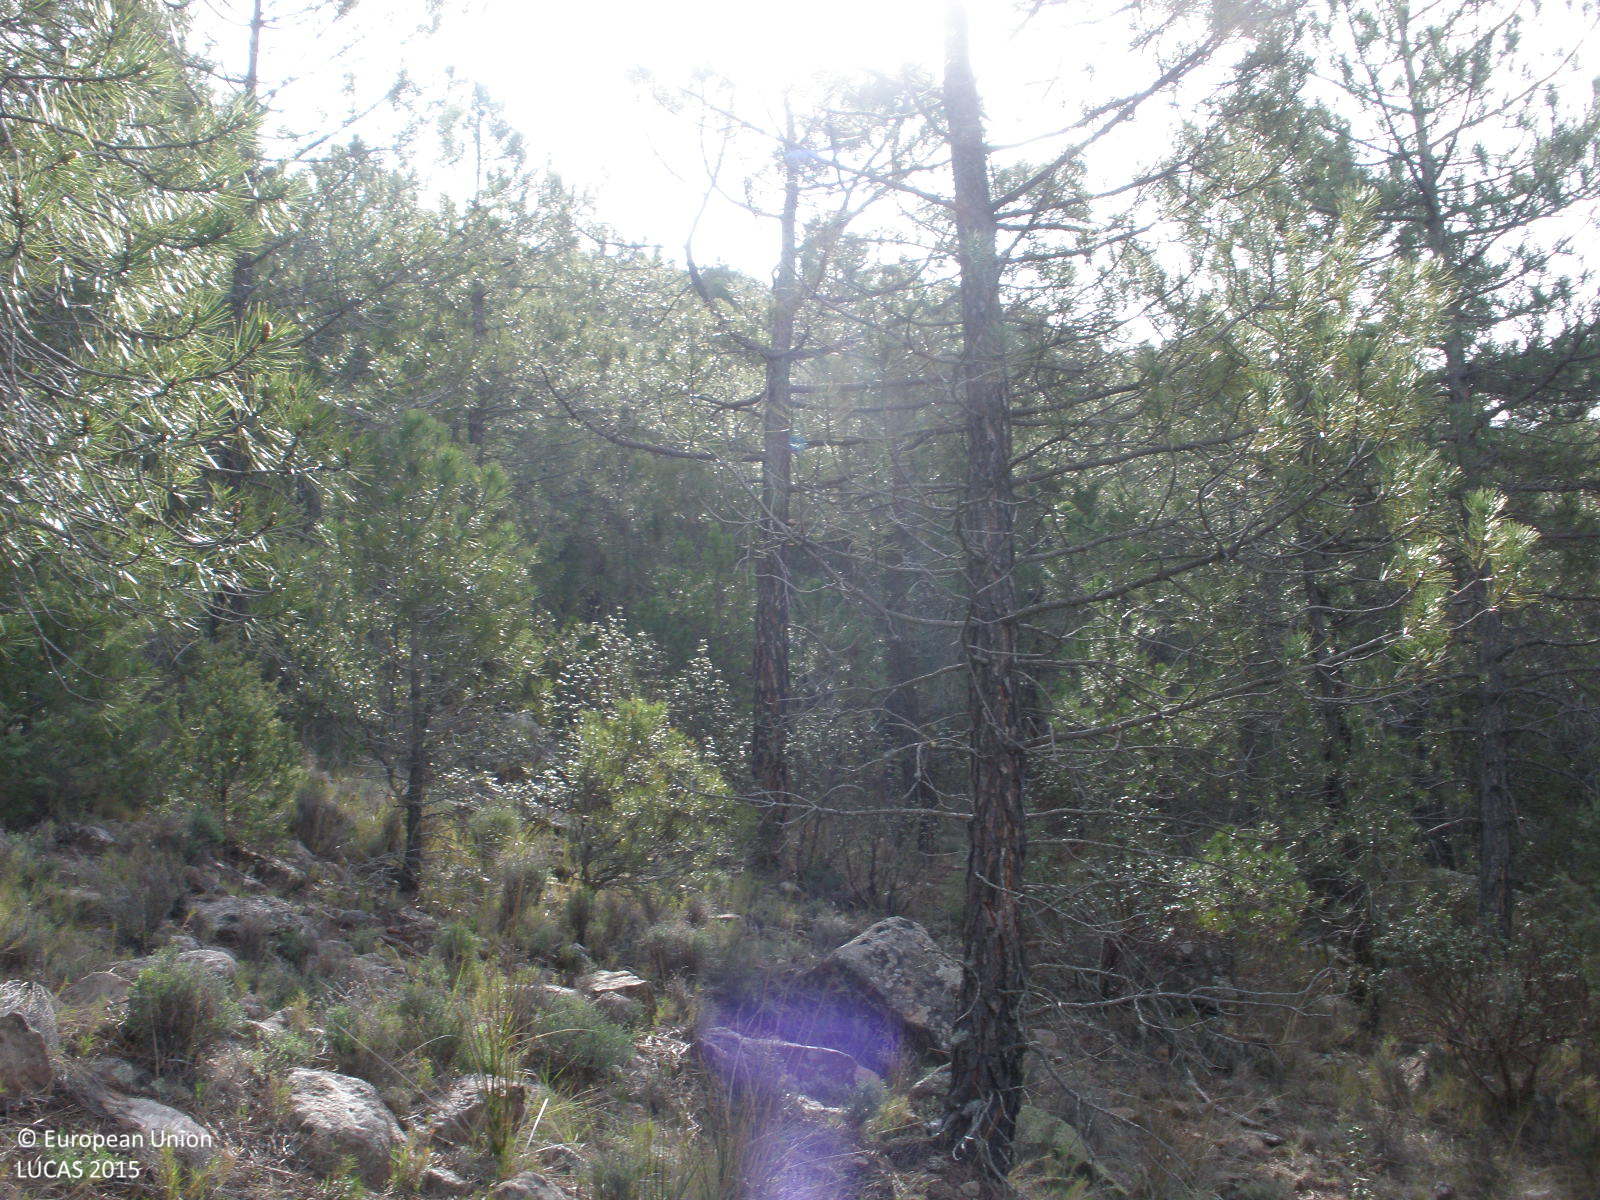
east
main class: Woodland
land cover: Pine dominated coniferous woodland
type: coniferous forest of the mediterranean region
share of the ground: > 75 %
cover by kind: coniferous forest trees 75 %, shrubs 20 %, consolidated bare surface 5 %
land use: Semi-natural and natural areas not in use
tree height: > 5 m
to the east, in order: Pine dominated coniferous woodland
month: April
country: ES
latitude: 40.3616
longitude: -0.8070
